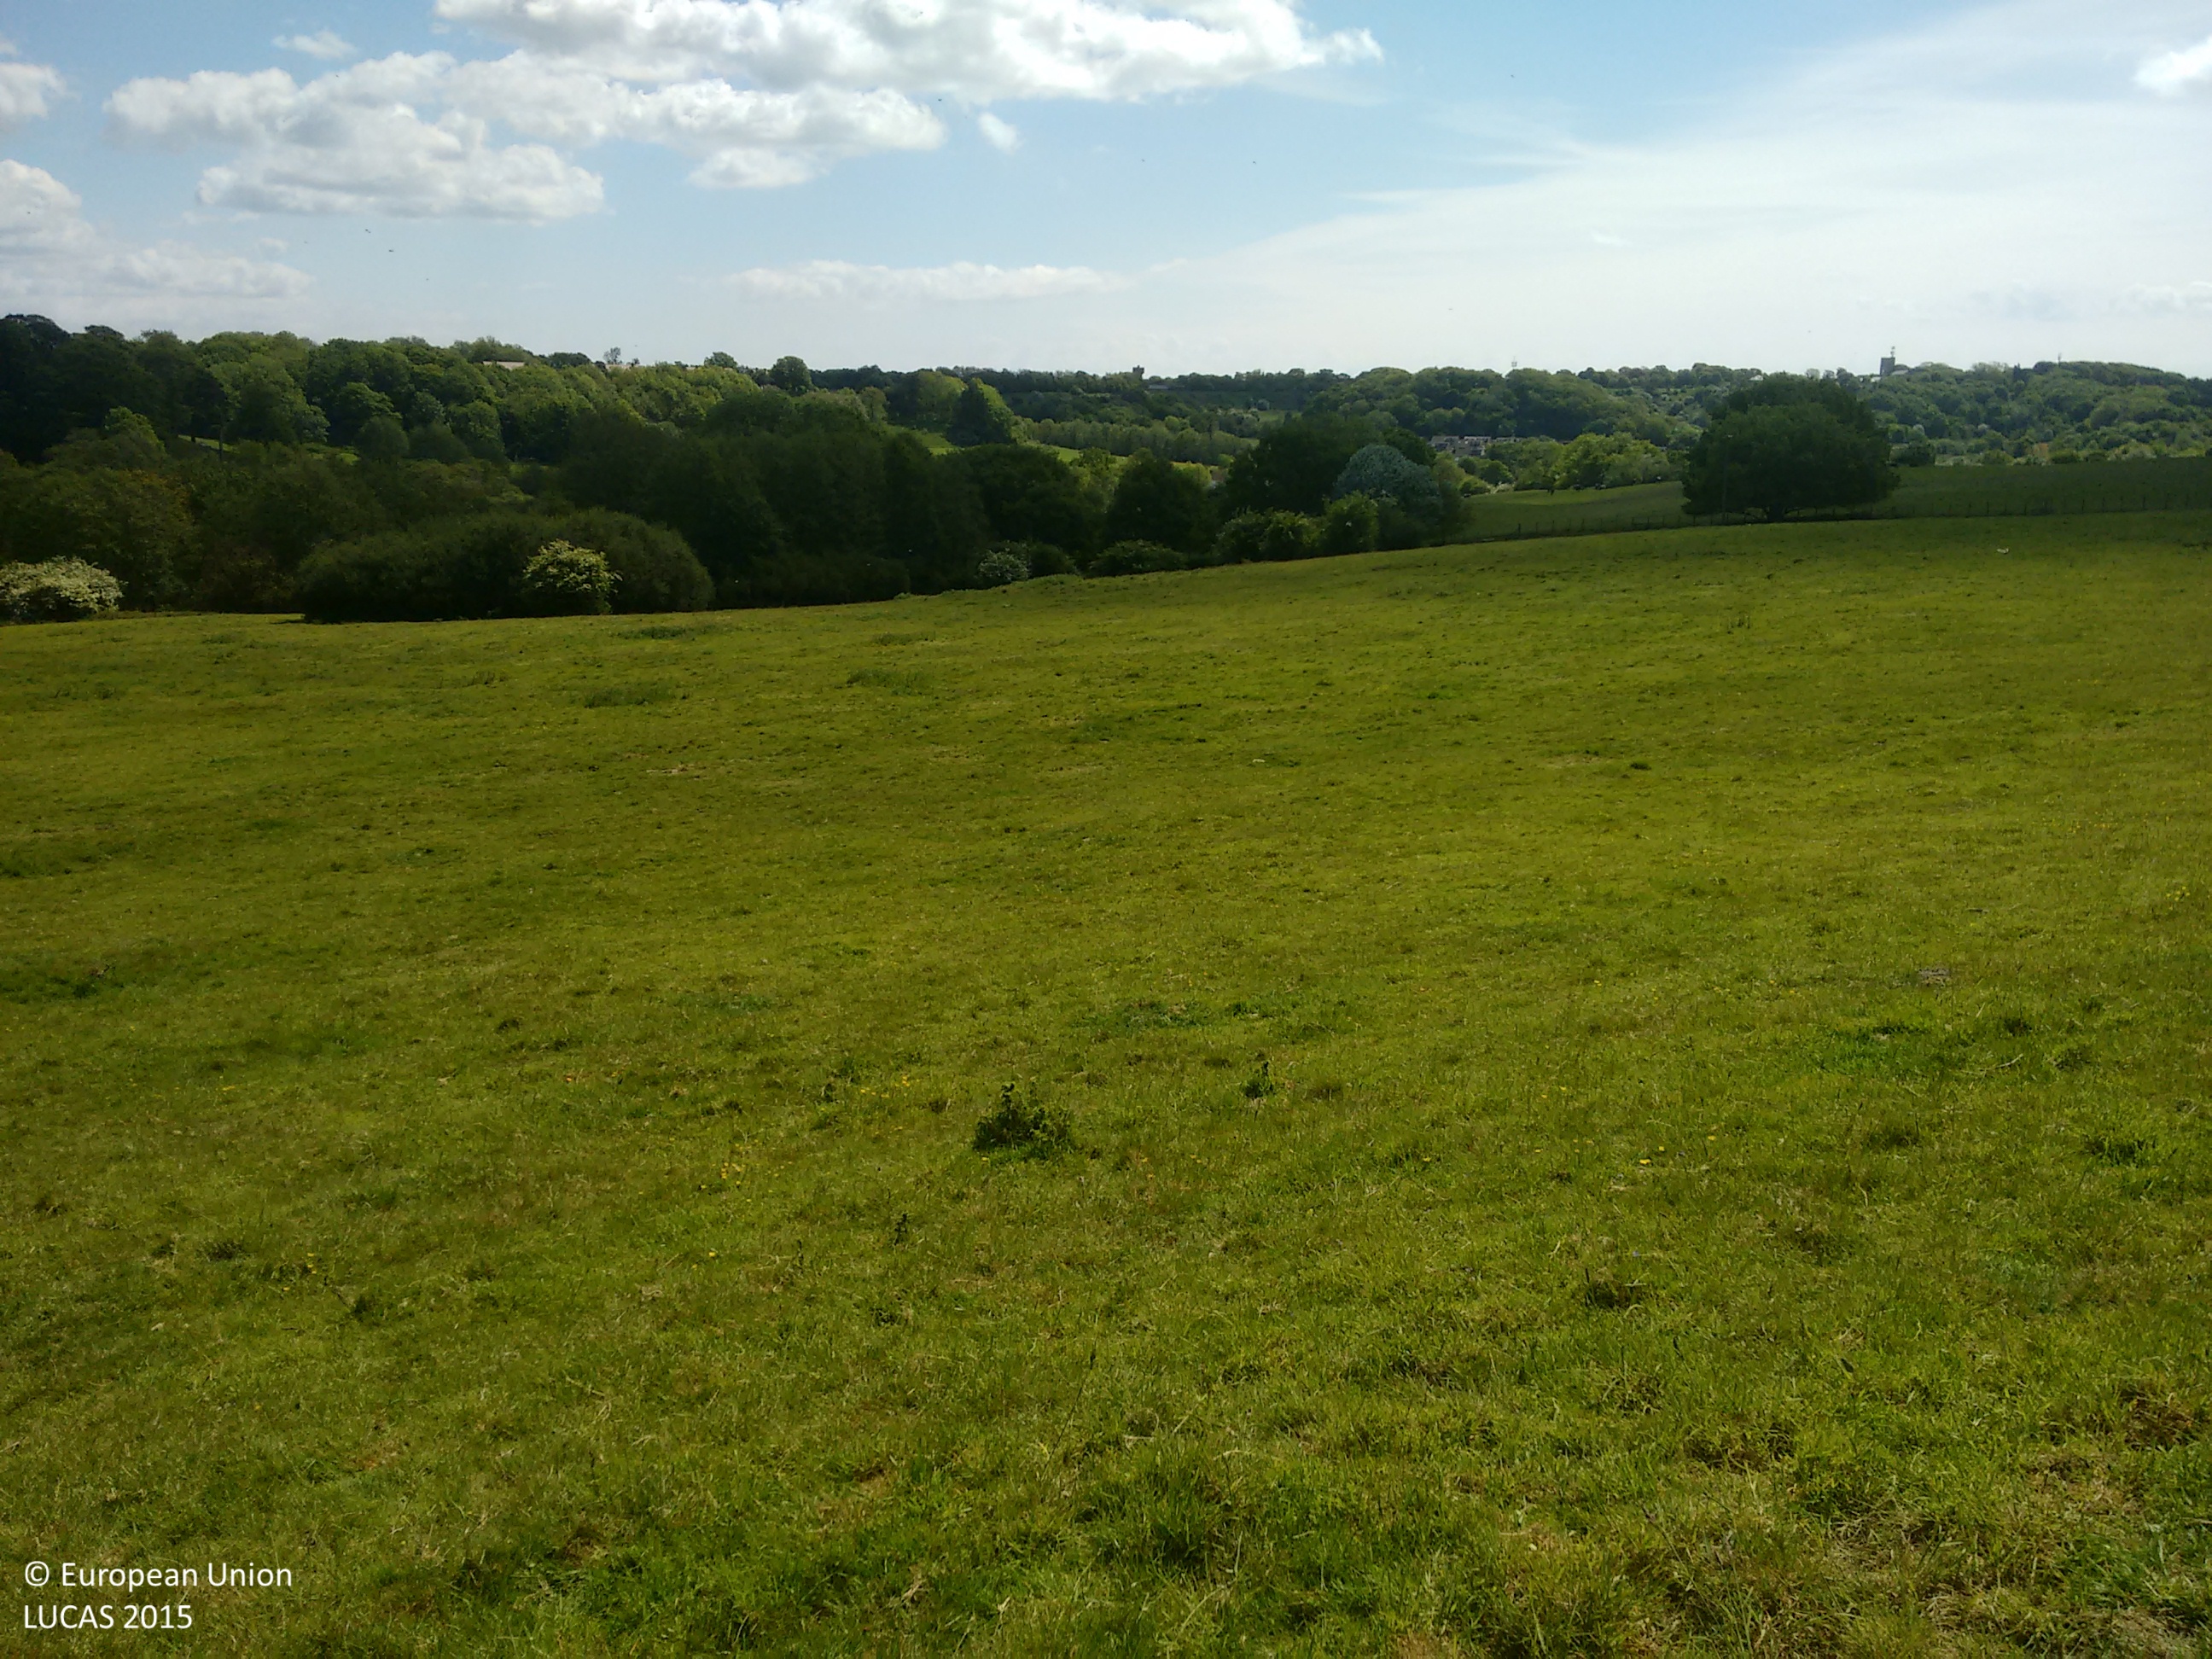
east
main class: Grassland
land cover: Grassland with sparse tree/shrub cover
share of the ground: > 75 %
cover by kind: herbaceous plants 85 %, shrubs 10 %, broadleaved forest trees 5 %
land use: Amenities, museums, leisure
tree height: < 5 m
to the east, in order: Grassland with sparse tree/shrub cover; Broadleaved woodland; Tracks; Fences; Broadleaved woodland
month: May
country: GB
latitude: 51.0849
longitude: 1.1123
